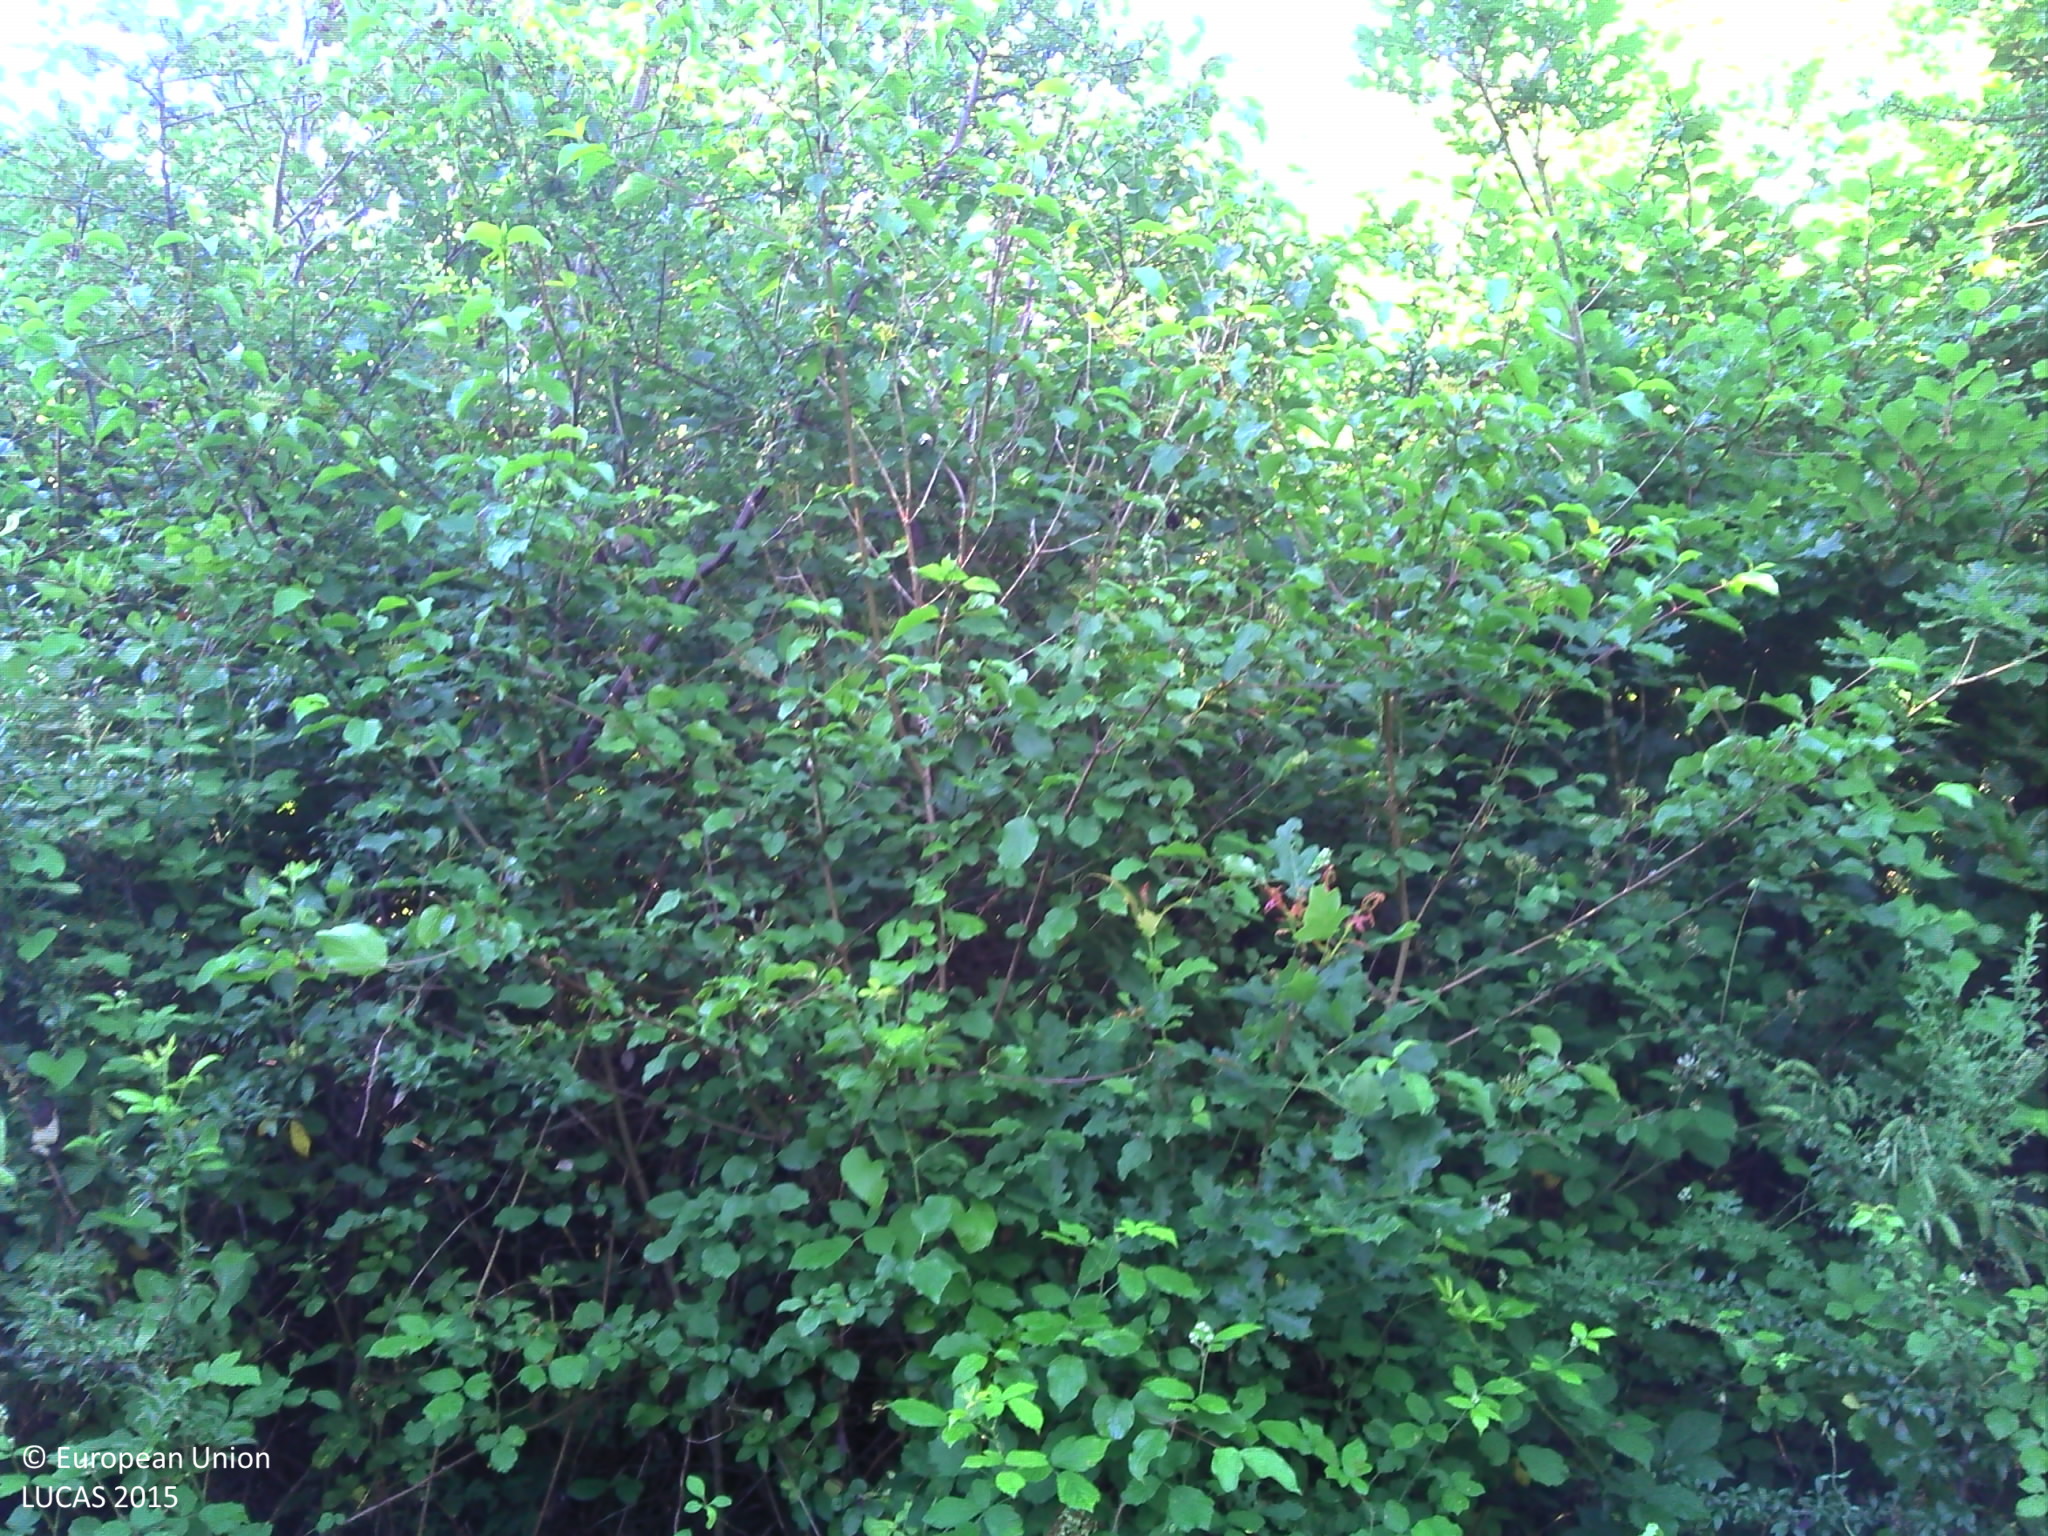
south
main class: Woodland
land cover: Broadleaved woodland
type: acidophilous oak and oak-birch forest
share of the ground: > 75 %
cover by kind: broadleaved forest trees 85 %, shrubs 10 %, herbaceous plants 5 %
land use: Semi-natural and natural areas not in use
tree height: > 5 m
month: June
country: FR
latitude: 45.8809
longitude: 0.3852
